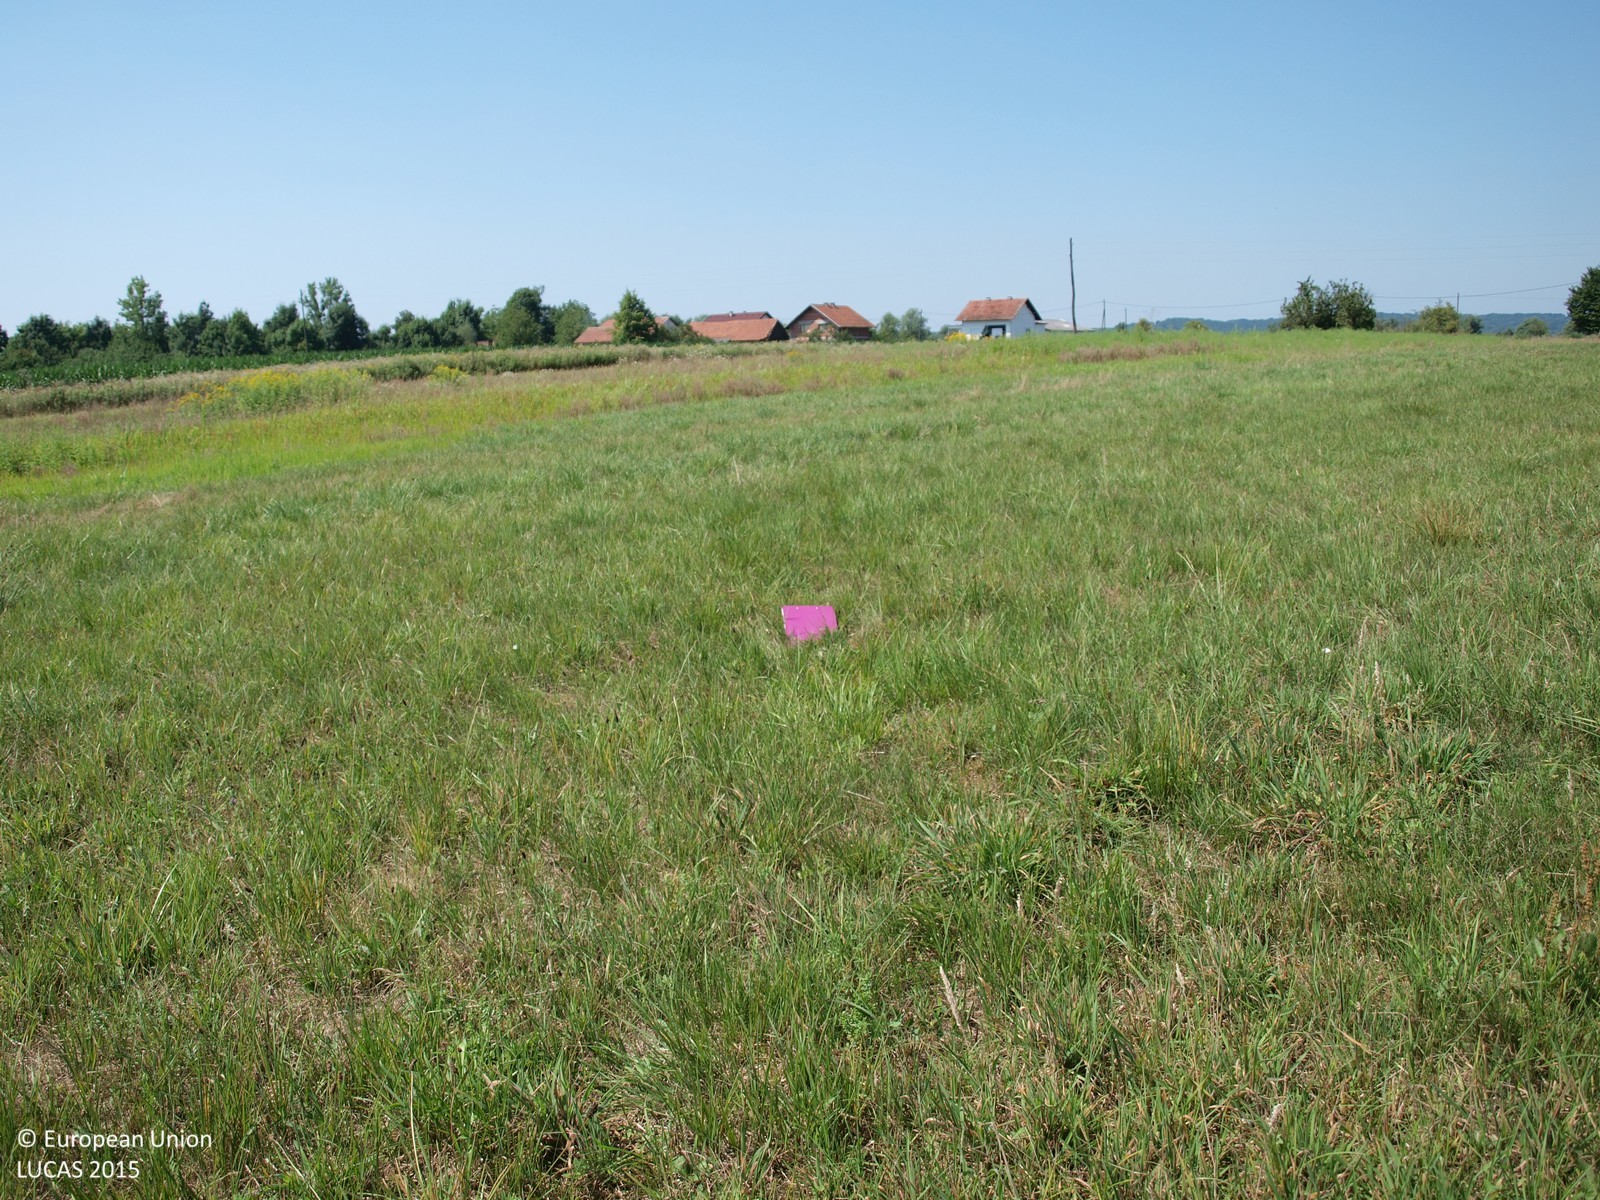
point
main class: Grassland
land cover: Grassland without tree/shrub cover
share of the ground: > 75 %
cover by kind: herbaceous plants 100 %
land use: Agriculture (excluding fallow land and kitchen gardens)
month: August
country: HR
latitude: 45.8749
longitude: 16.3246
